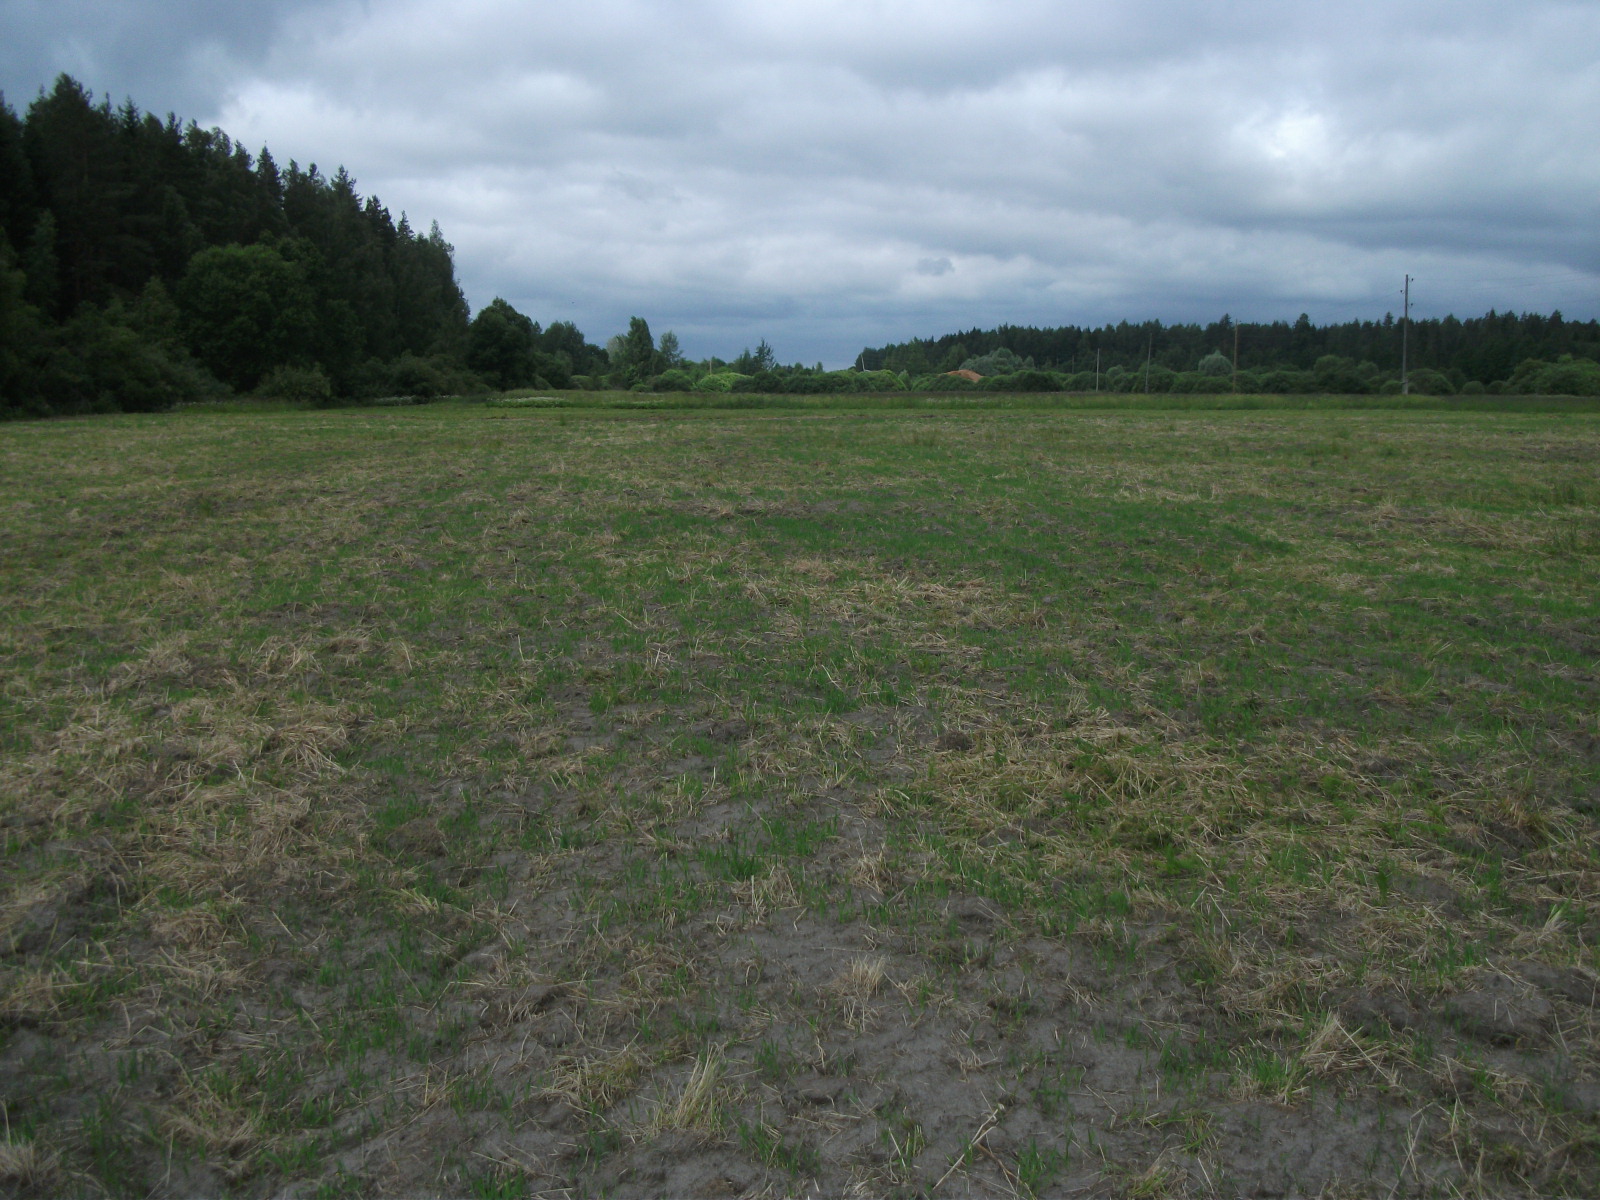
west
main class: Grassland
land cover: Grassland without tree/shrub cover
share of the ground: 50 - 75 %
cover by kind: herbaceous plants 70 %, unconsolidated bare surface 30 %
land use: Agriculture (excluding fallow land and kitchen gardens)
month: January
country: LV
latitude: 56.8890
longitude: 26.6800
